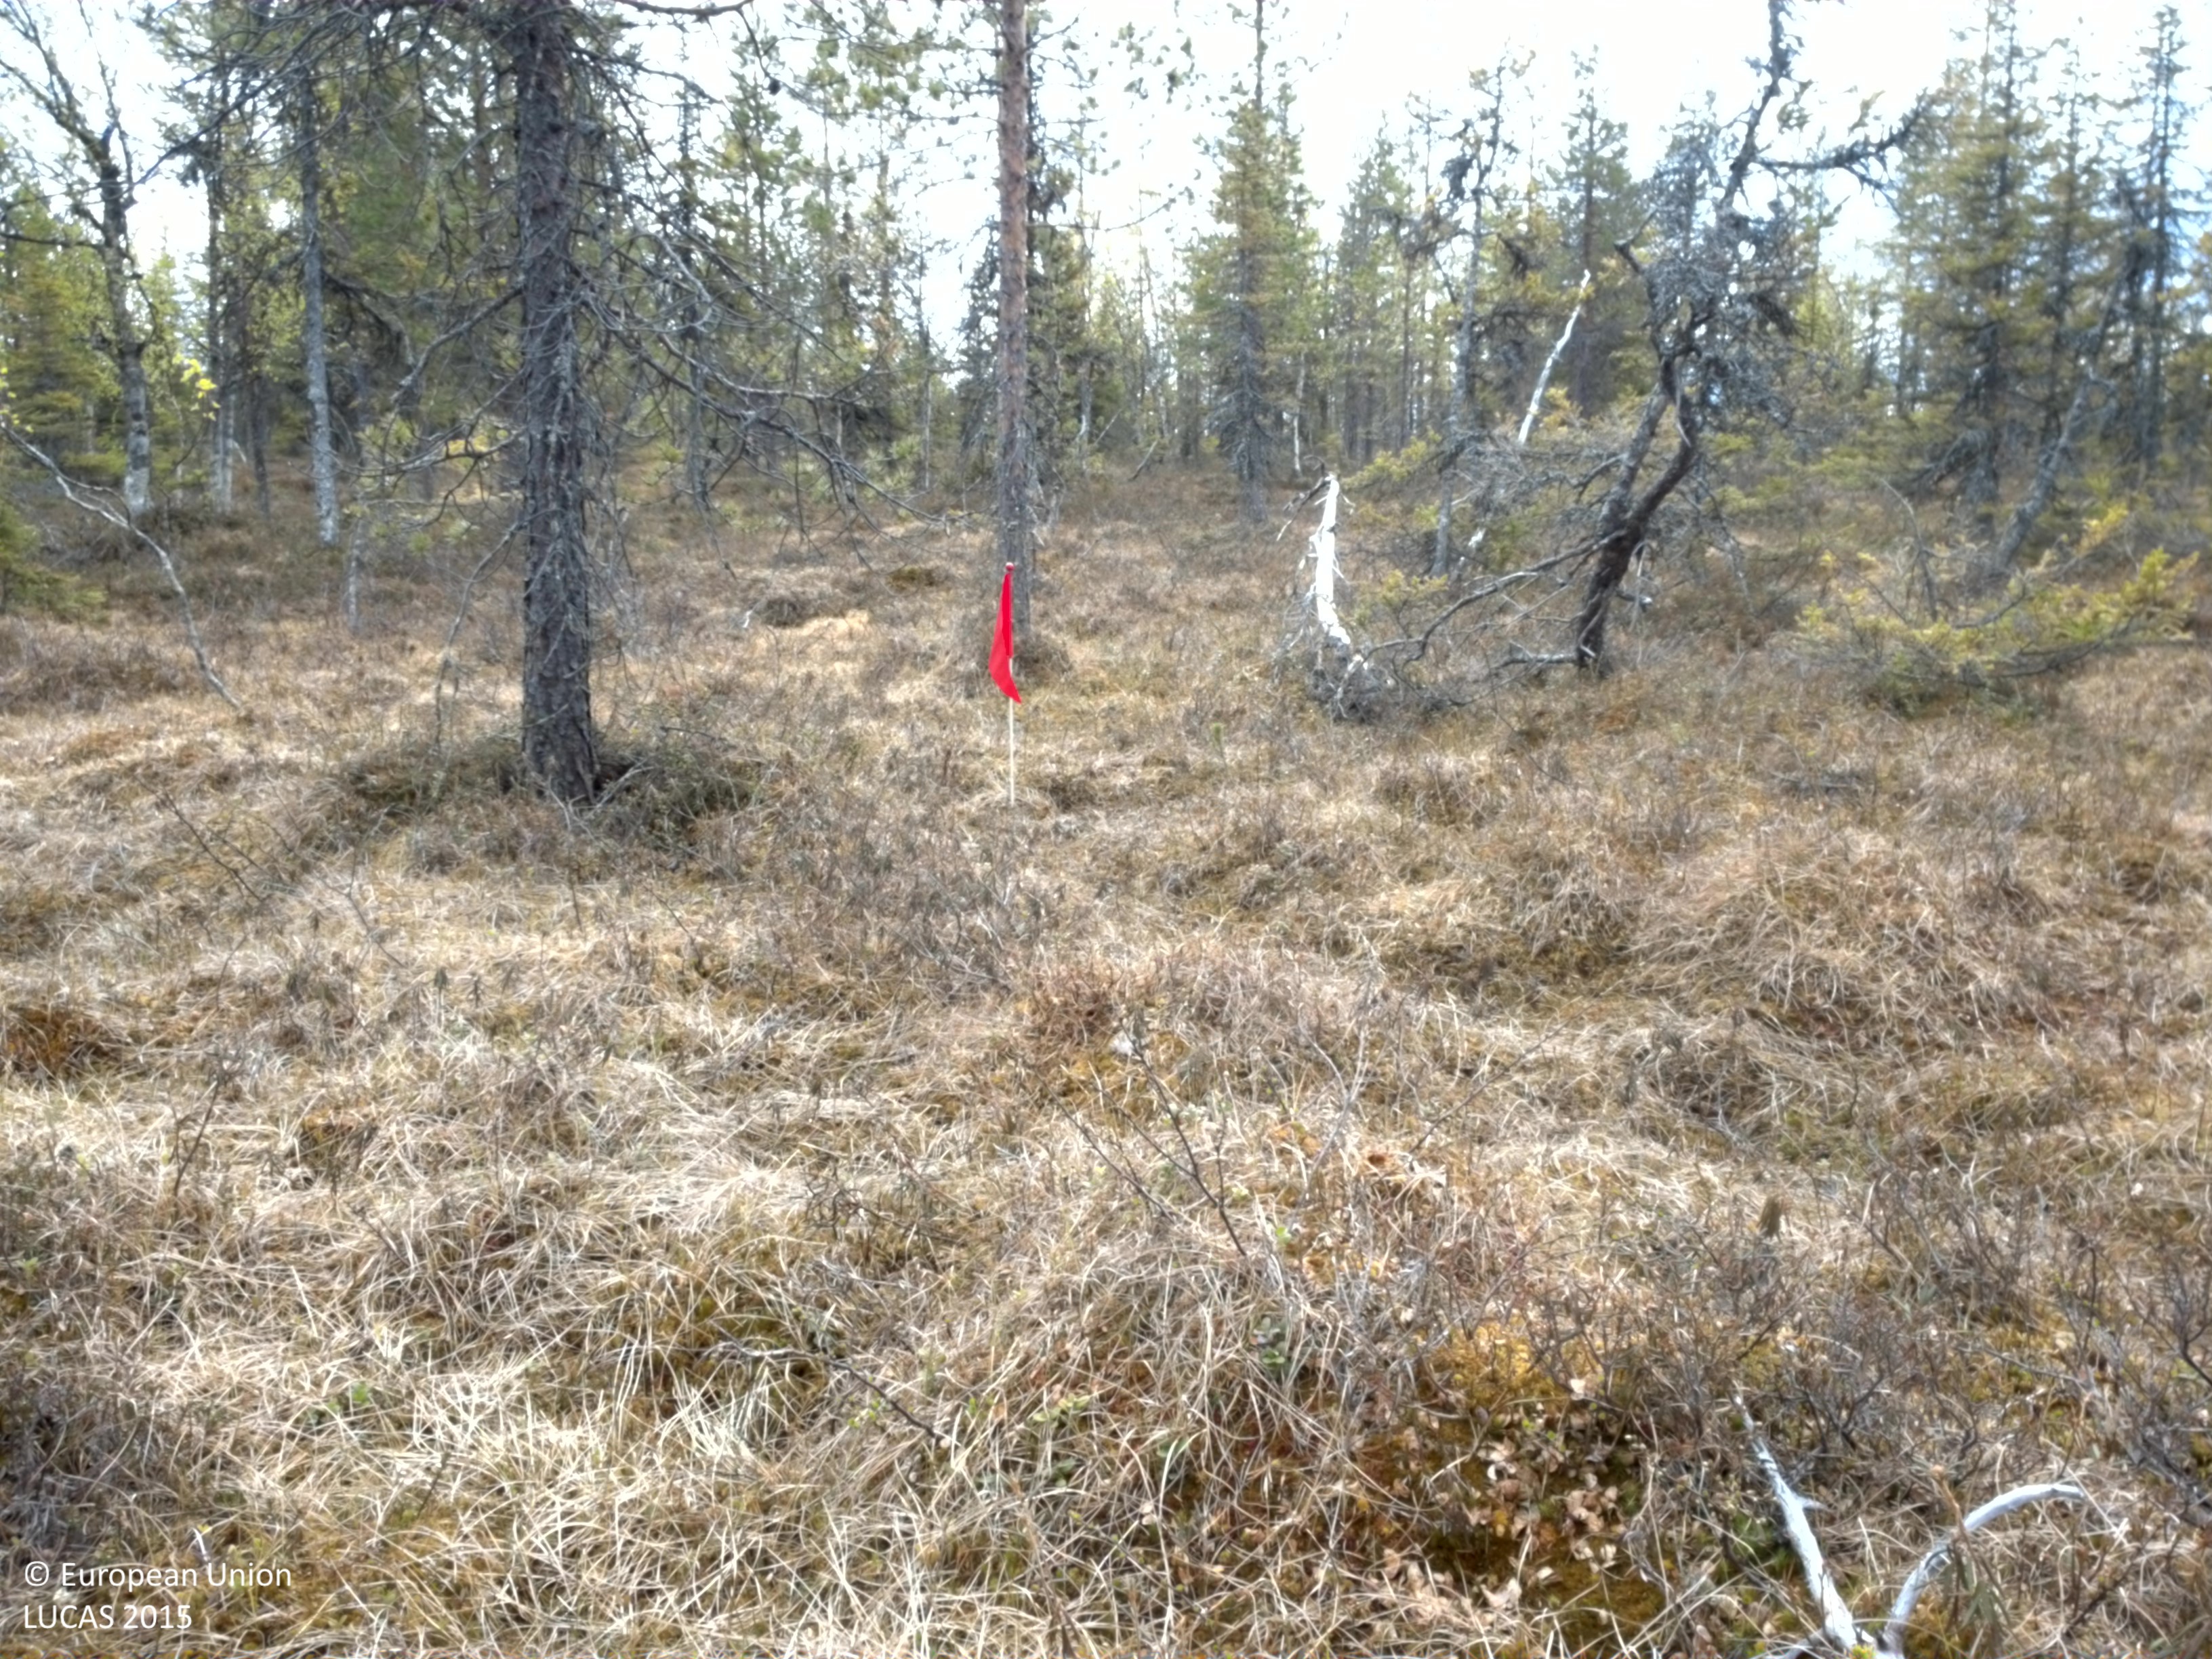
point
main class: Woodland
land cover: Pine dominated coniferous woodland
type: mire and swamp forests
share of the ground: 10 - 25 %
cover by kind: shrubs 50 %, herbaceous plants 35 %, coniferous forest trees 15 %
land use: Semi-natural and natural areas not in use
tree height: > 5 m
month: June
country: SE
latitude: 66.0823
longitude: 18.8192
